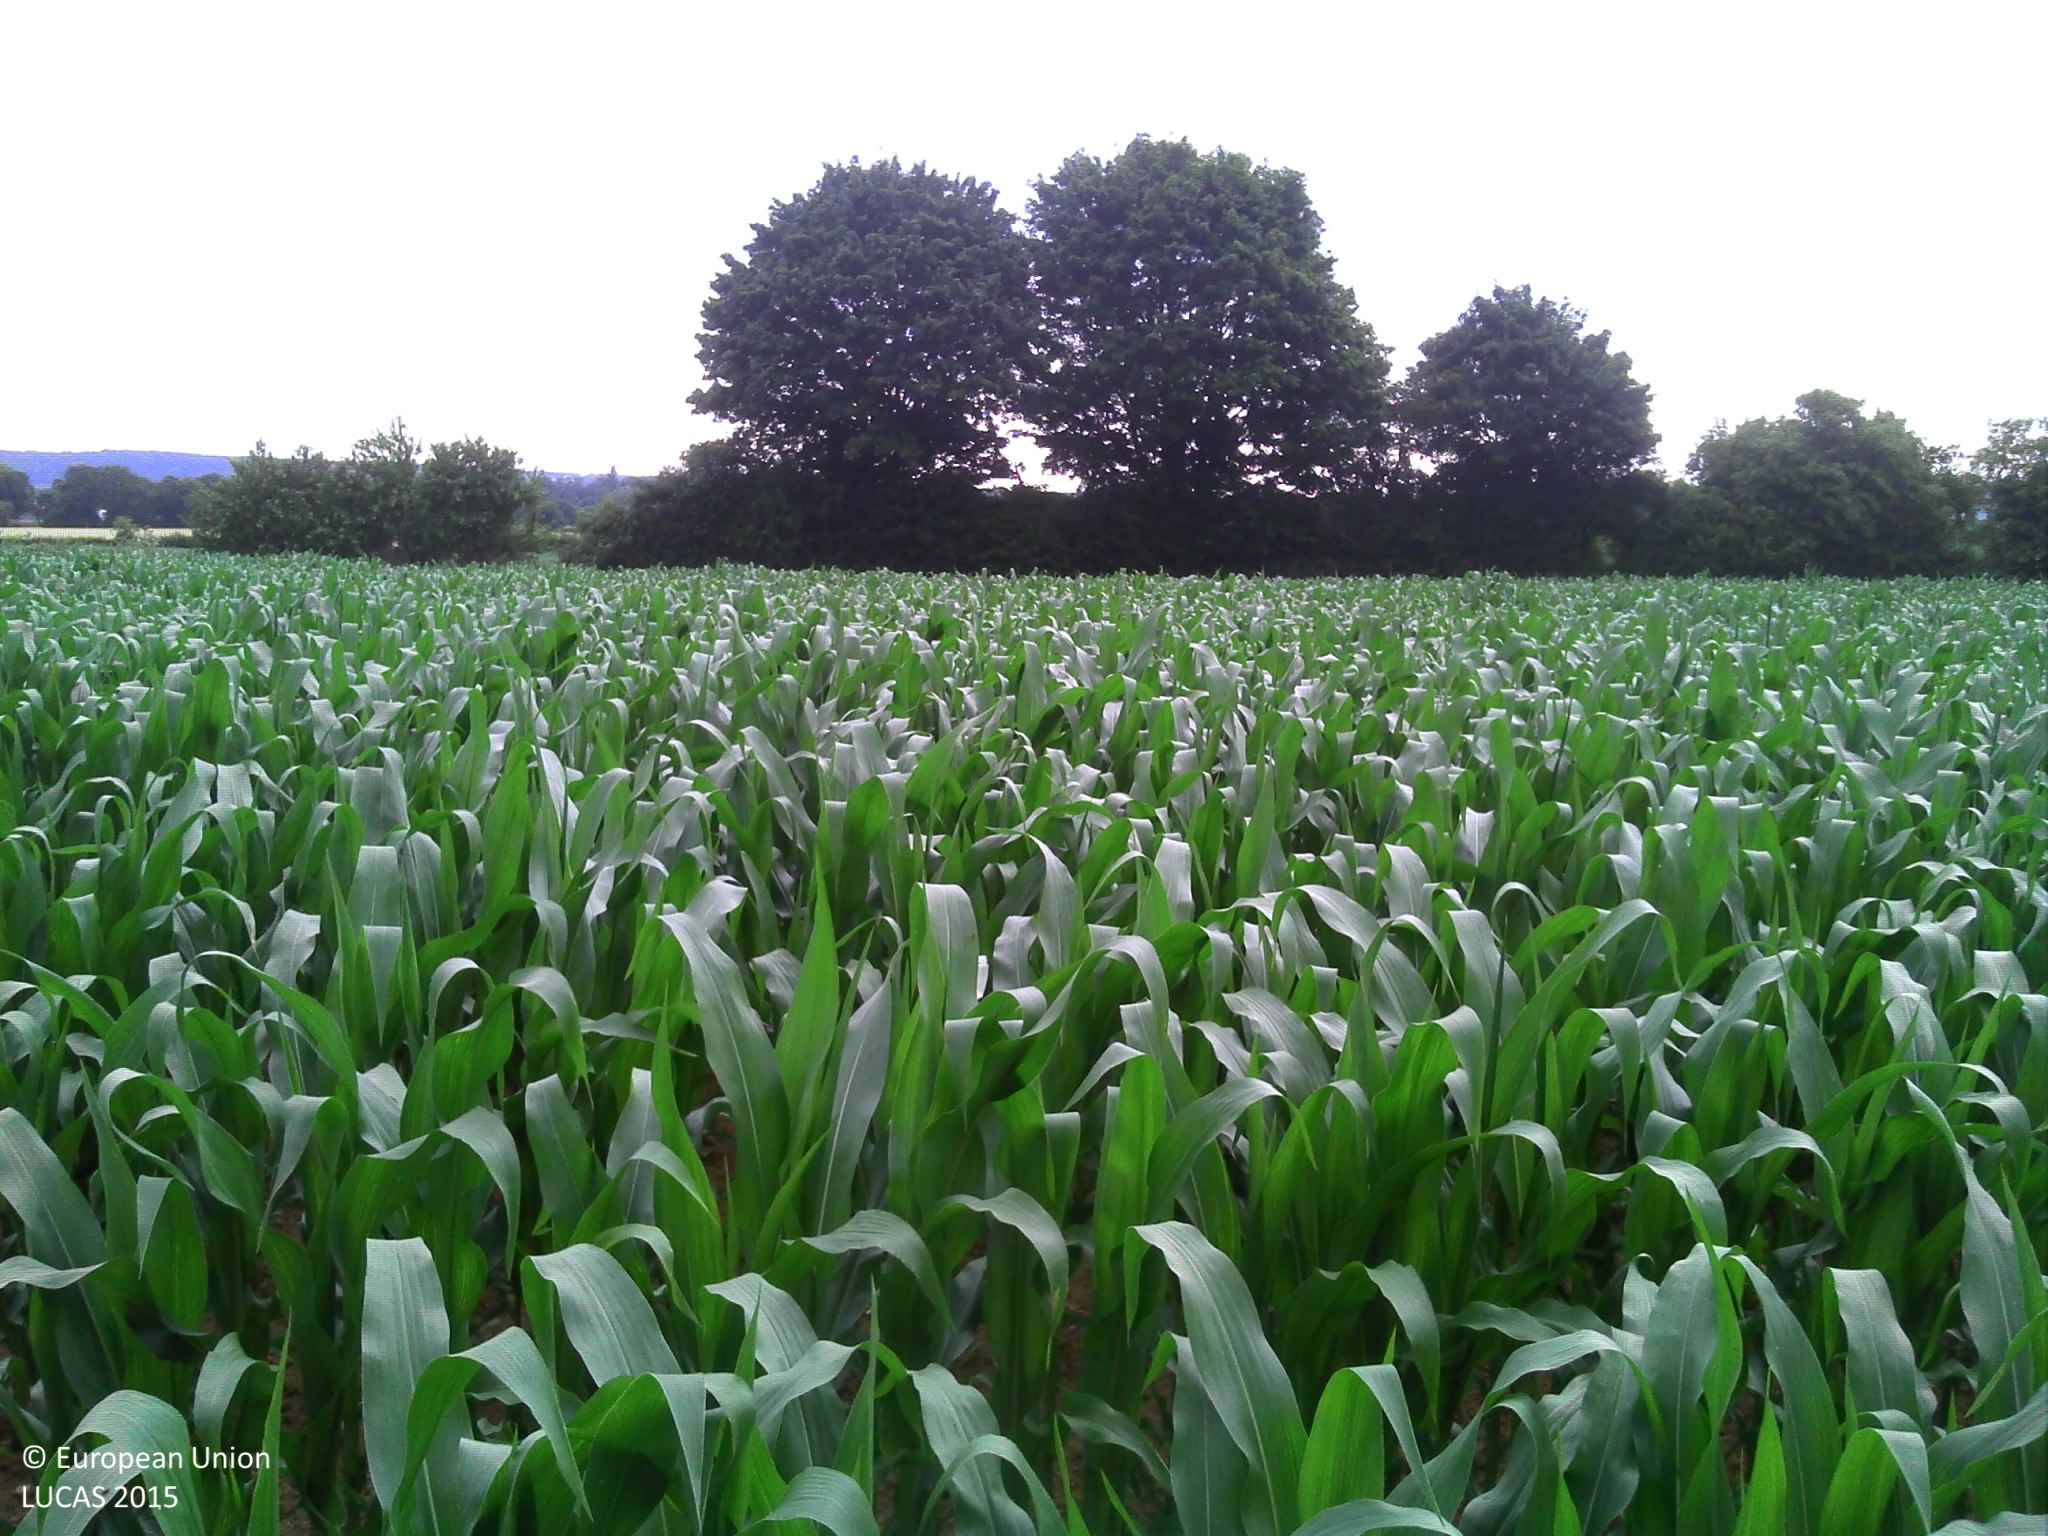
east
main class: Cropland
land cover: Maize
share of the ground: > 75 %
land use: Agriculture (excluding fallow land and kitchen gardens)
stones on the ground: < 10 %
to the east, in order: Maize; Grass margins; Ditches and canals; Broadleaved woodland; Grass margins; Dry pulses; Grassland without tree/shrub cover; Ditches and canals; Grassland without tree/shrub cover; Dry pulses
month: July
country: FR
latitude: 48.9653
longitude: 0.0118
